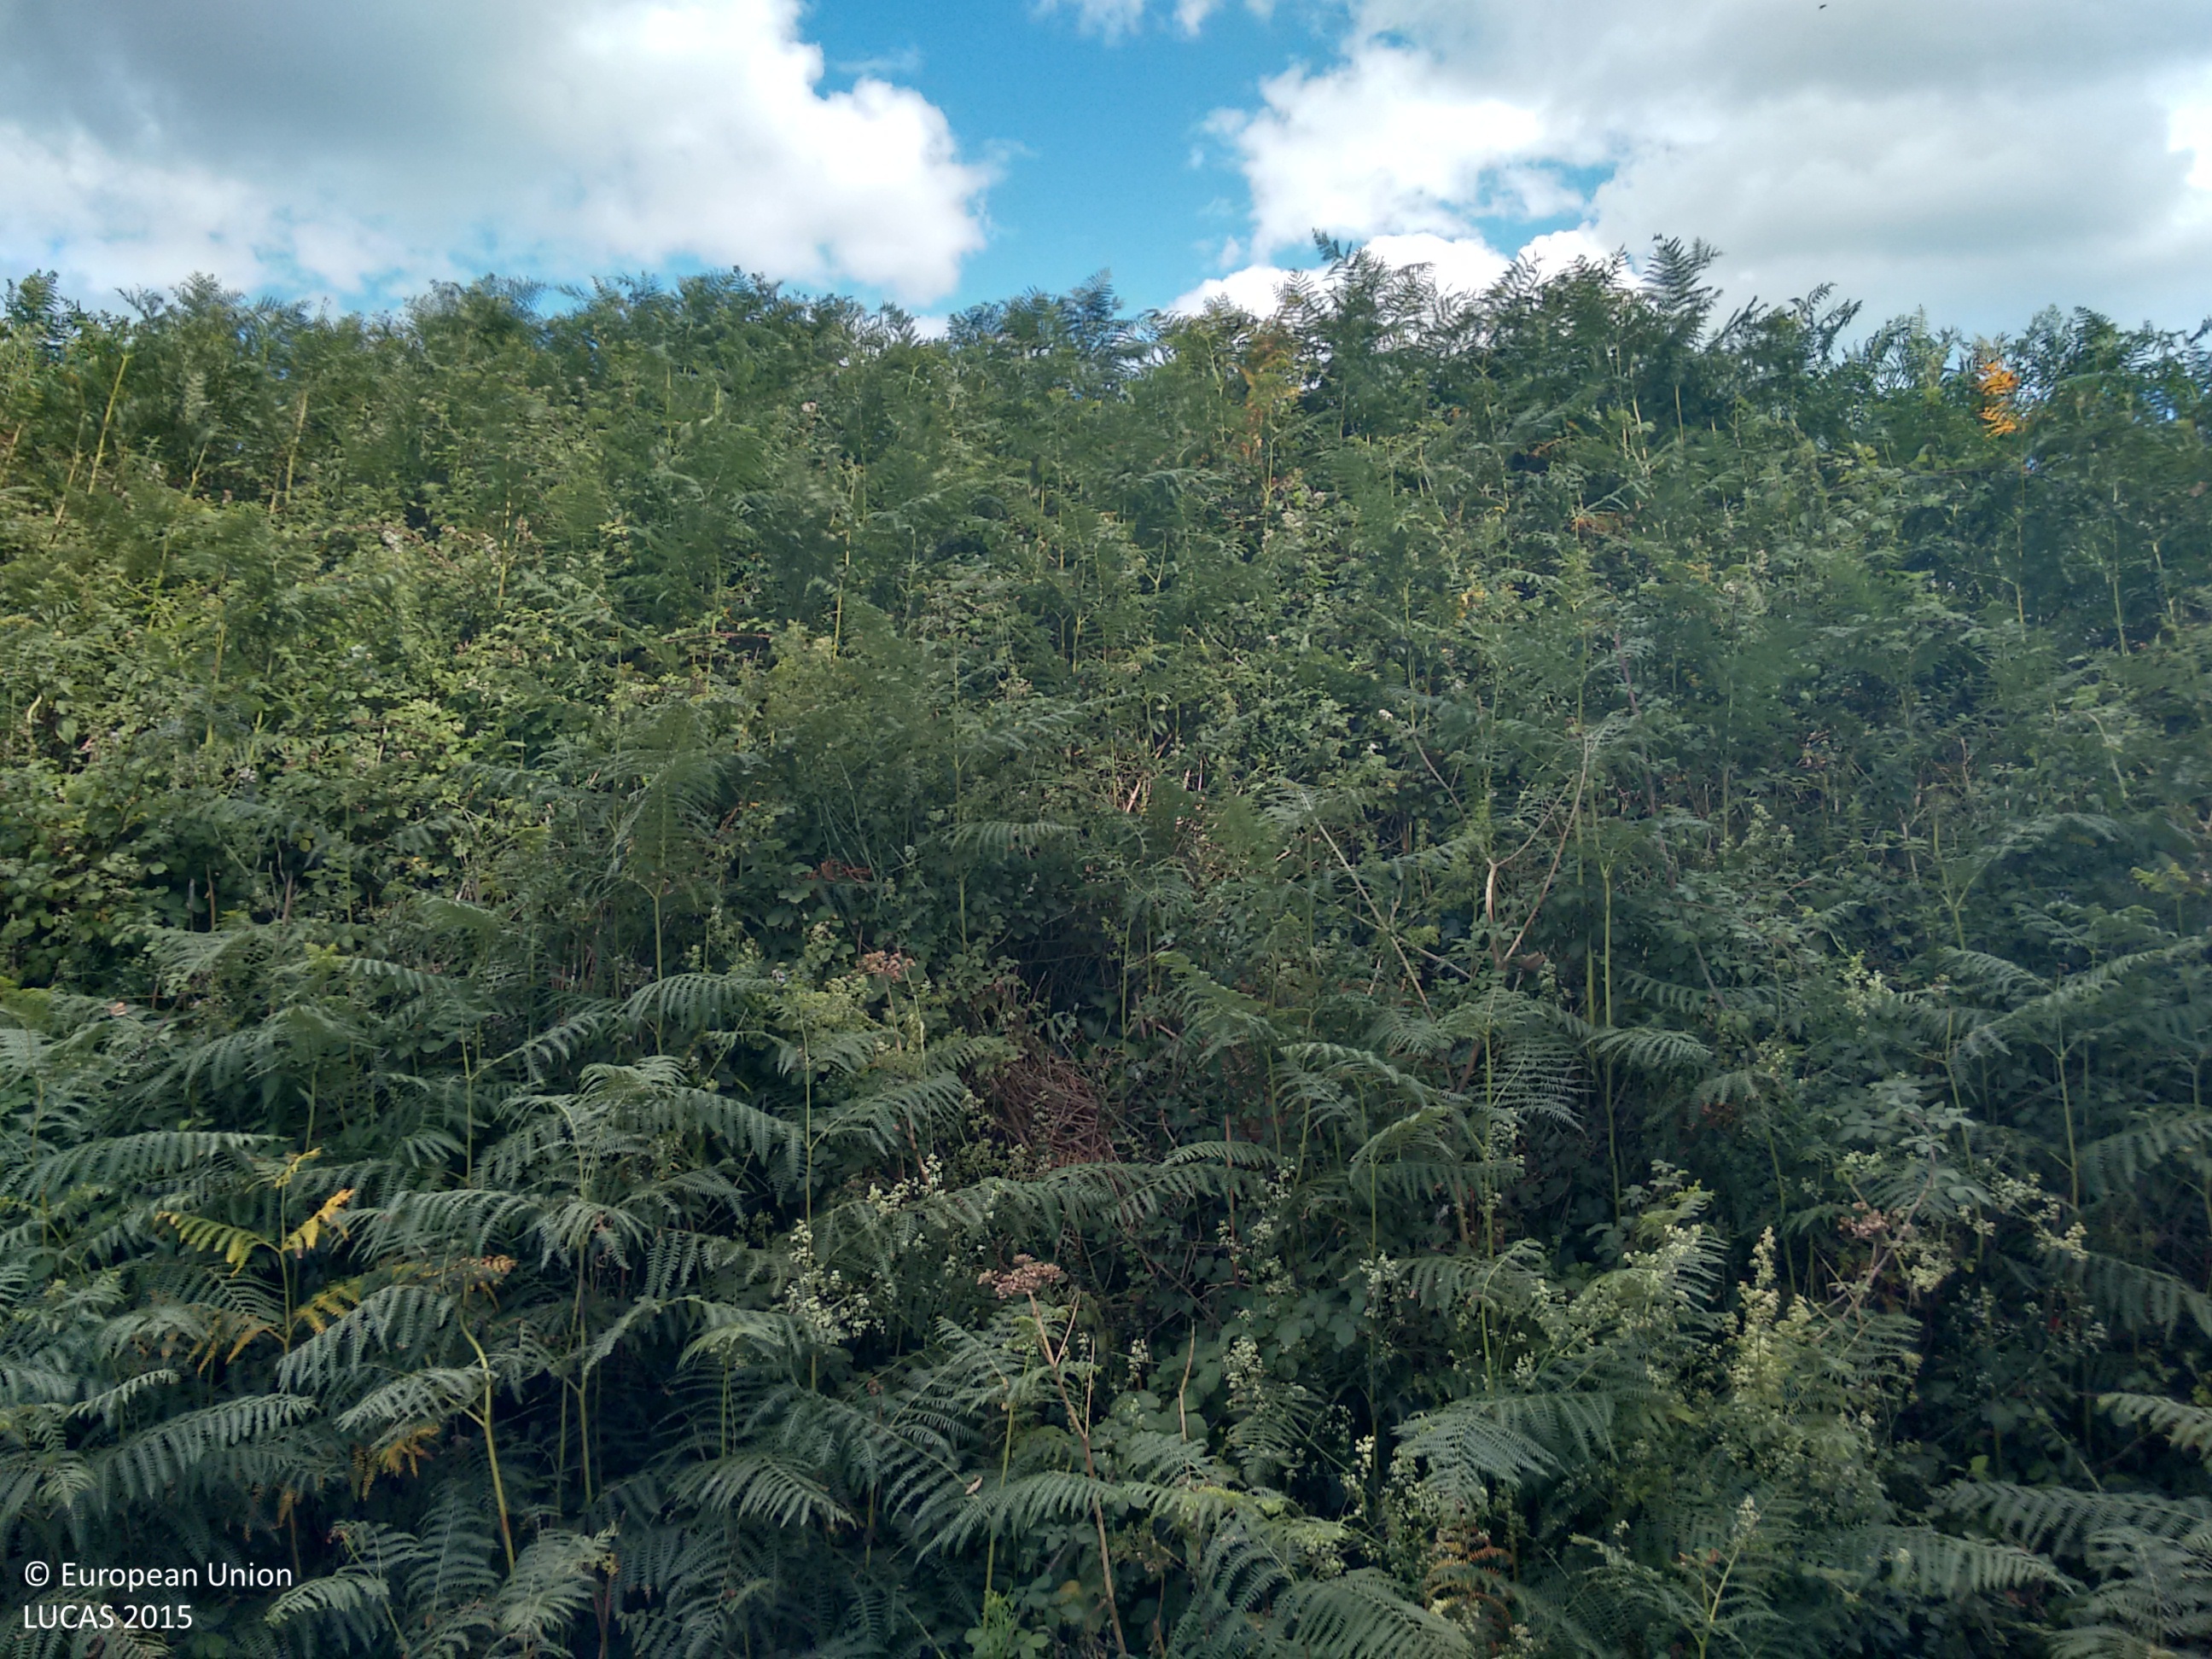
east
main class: Cropland
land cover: Maize
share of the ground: > 75 %
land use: Agriculture (excluding fallow land and kitchen gardens)
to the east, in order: Maize; Grass margins; Managed hedges; Tracks; Shruby margins; Grassland without tree/shrub cover; Managed hedges; Grass margins; Grassland without tree/shrub cover
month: July
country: GB
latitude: 50.6401
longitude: -3.3013
